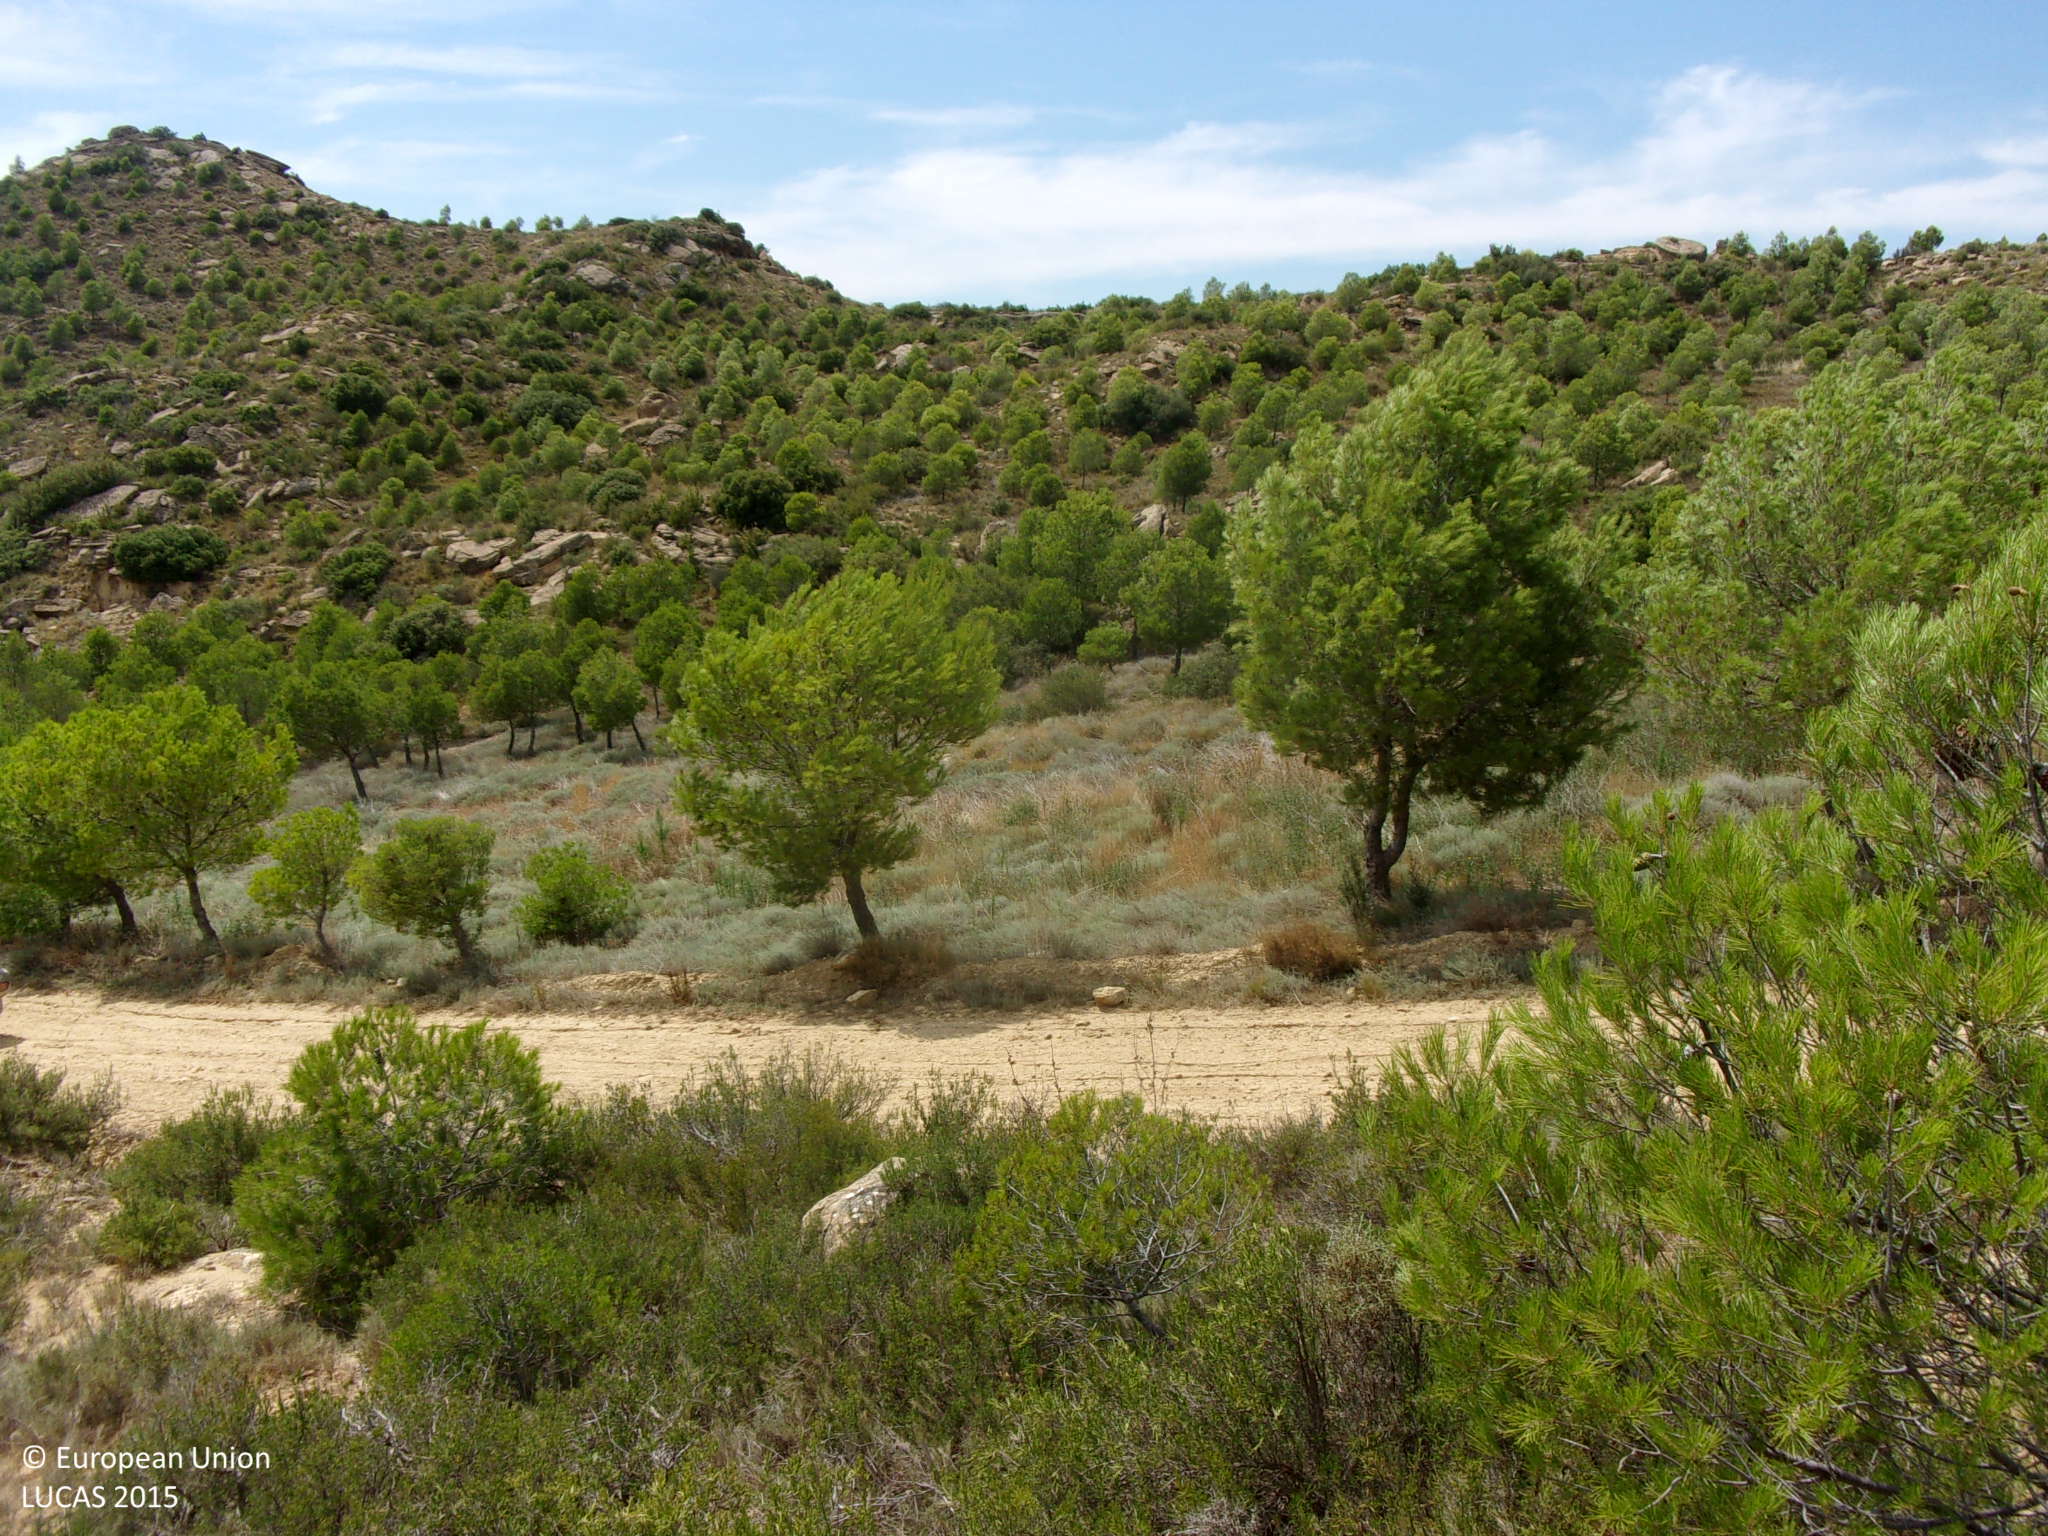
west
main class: Woodland
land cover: Pine dominated coniferous woodland
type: coniferous forest of the mediterranean region
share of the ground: 10 - 25 %
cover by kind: shrubs 50 %, coniferous forest trees 35 %, consolidated bare surface 15 %
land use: Forestry
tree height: < 5 m
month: August
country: ES
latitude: 42.1895
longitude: -1.0836
